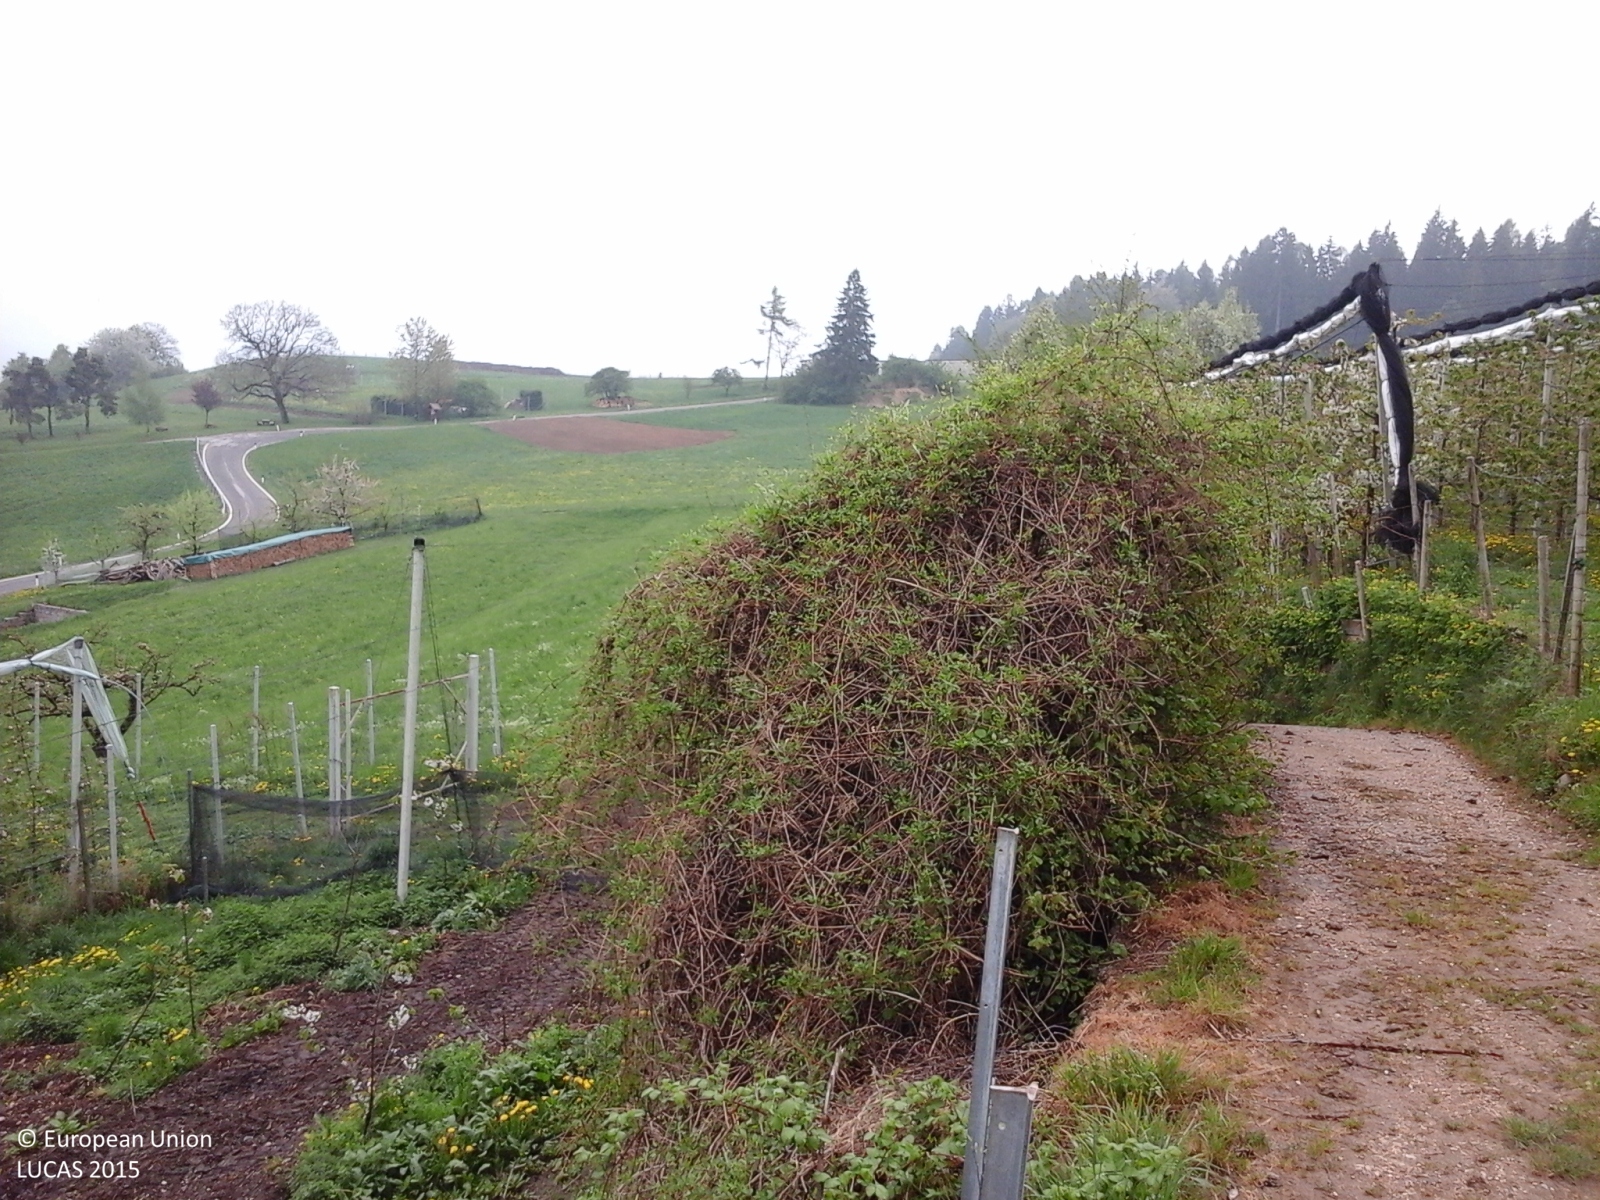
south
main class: Cropland
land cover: Apple fruit
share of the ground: 50 - 75 %
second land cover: Grassland without tree/shrub cover
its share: 25 - 50 %
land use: Agriculture (excluding fallow land and kitchen gardens)
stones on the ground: < 10 %
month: May
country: IT
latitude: 46.4536
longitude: 11.1052
